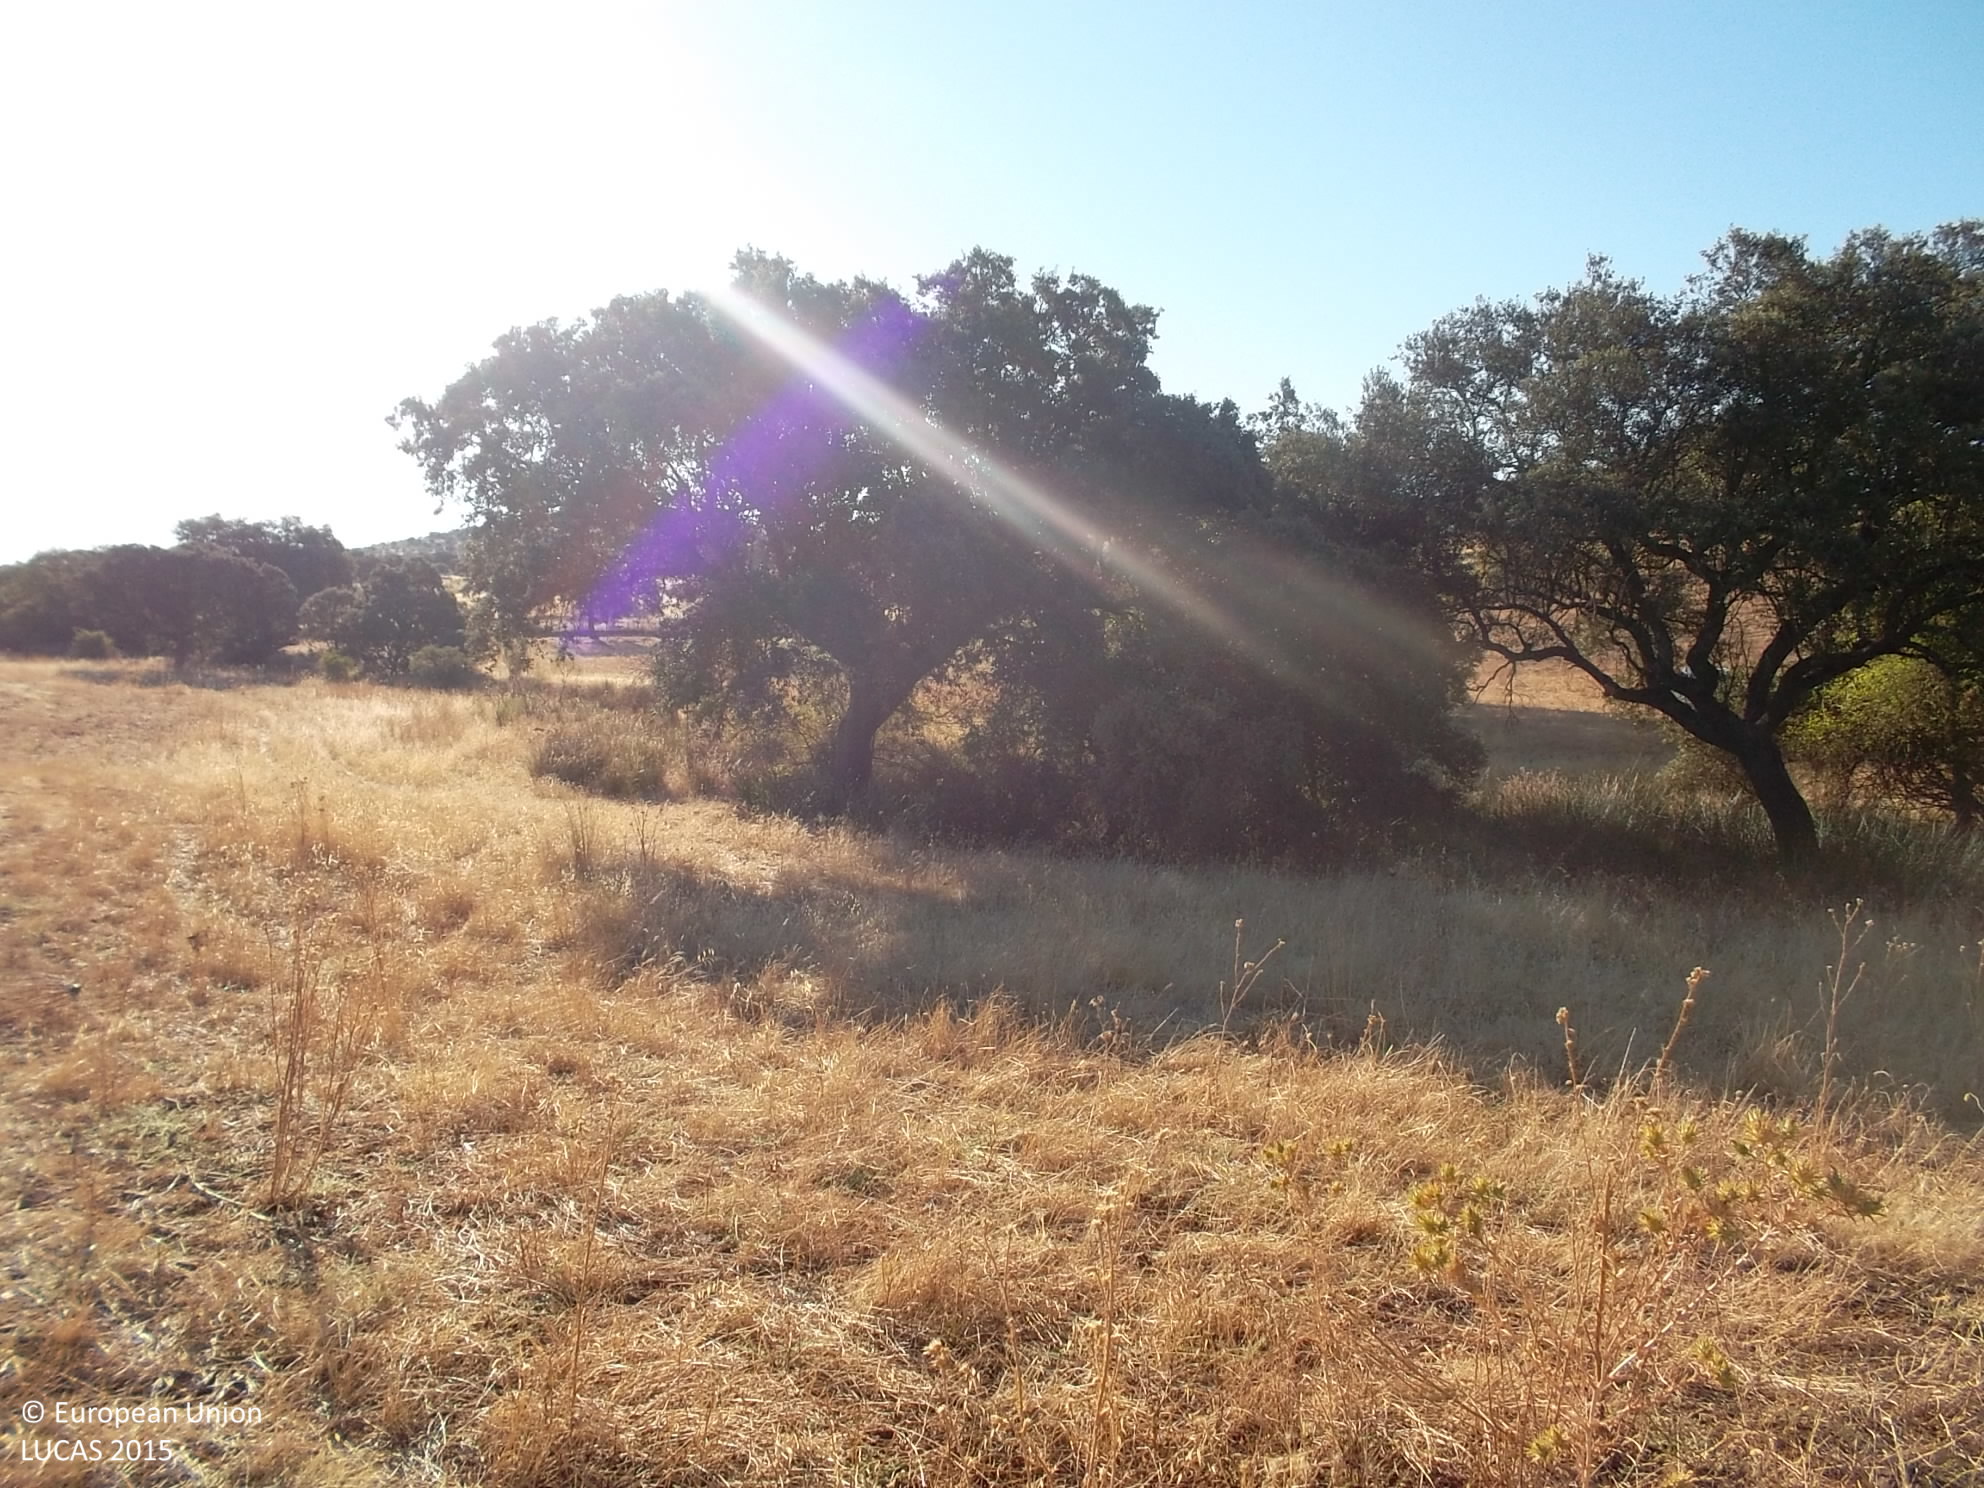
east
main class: Grassland
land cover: Grassland with sparse tree/shrub cover
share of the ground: > 75 %
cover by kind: herbaceous plants 95 %, broadleaved forest trees 5 %
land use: Agriculture (excluding fallow land and kitchen gardens)
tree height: < 5 m
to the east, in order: Grassland with sparse tree/shrub cover; Groves; Rivers and streams; Grassland with sparse tree/shrub cover; Tracks; Fences; Grassland with sparse tree/shrub cover
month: July
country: ES
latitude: 38.4918
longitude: -5.7349
